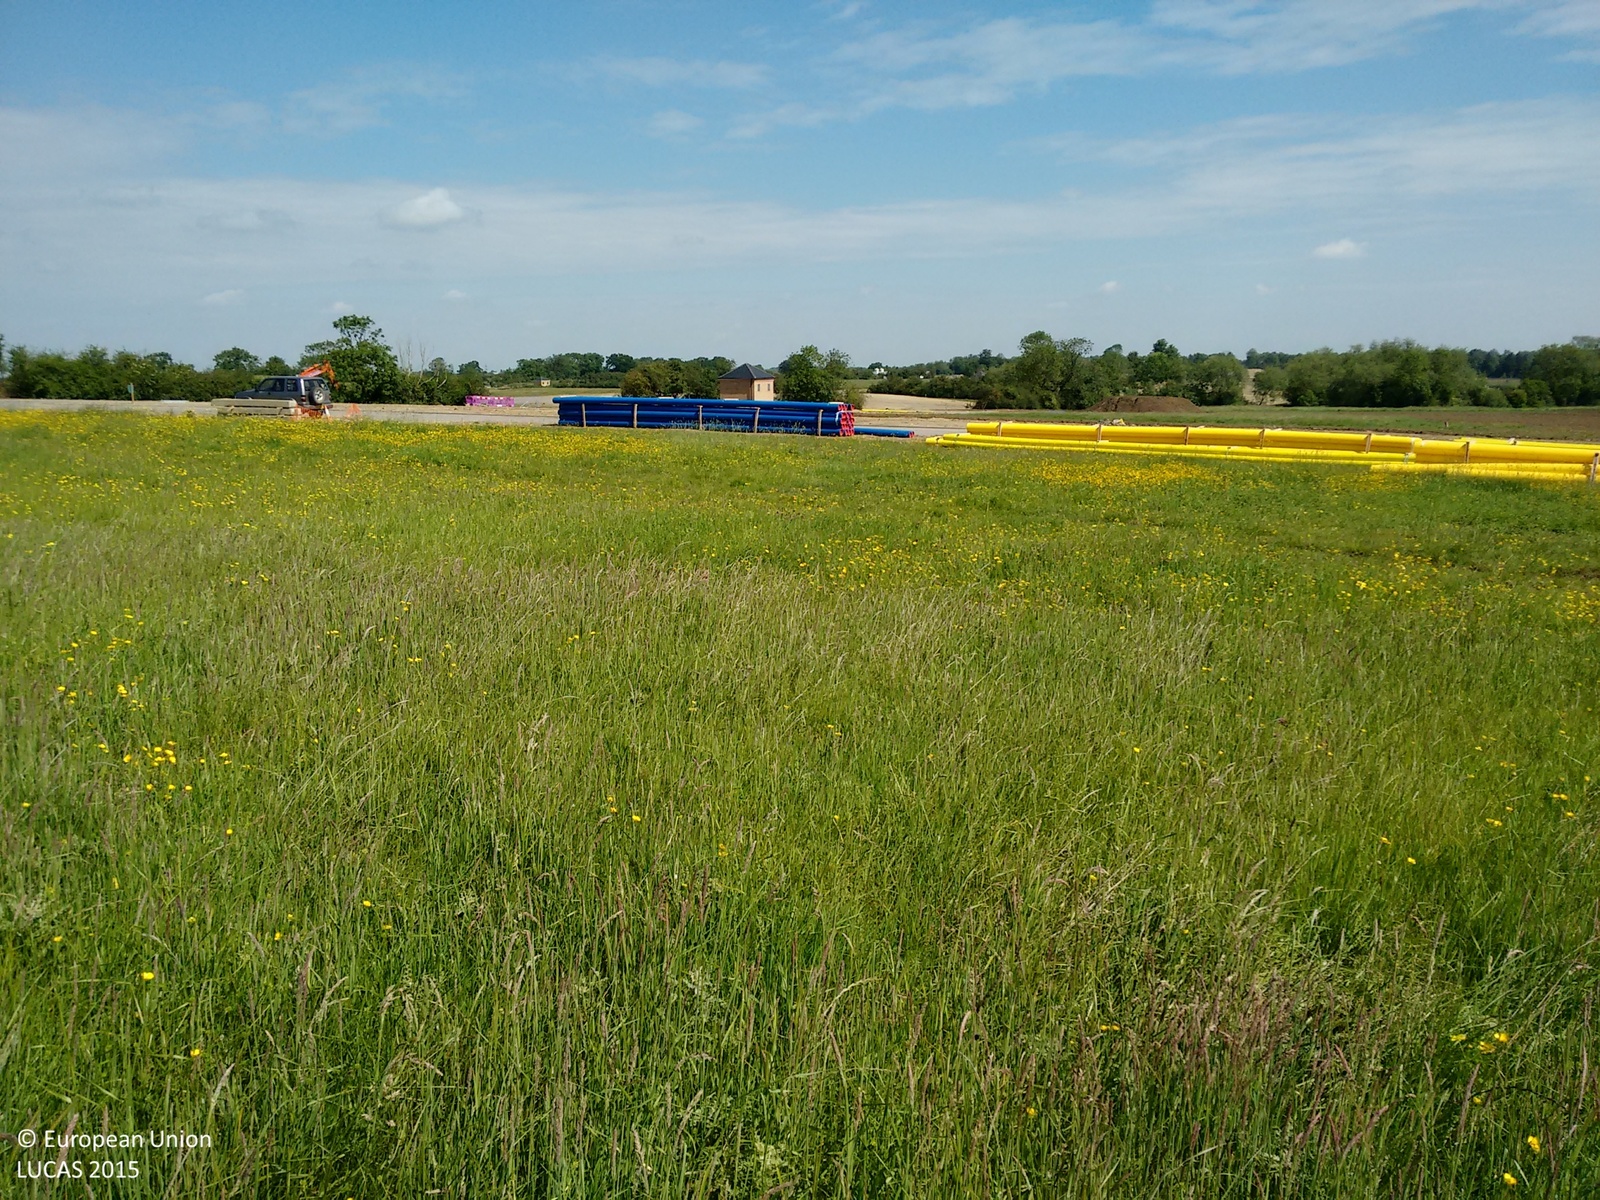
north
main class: Grassland
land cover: Grassland without tree/shrub cover
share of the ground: > 75 %
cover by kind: herbaceous plants 100 %
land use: Agriculture (excluding fallow land and kitchen gardens)
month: June
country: GB
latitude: 52.0272
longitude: -0.8127
